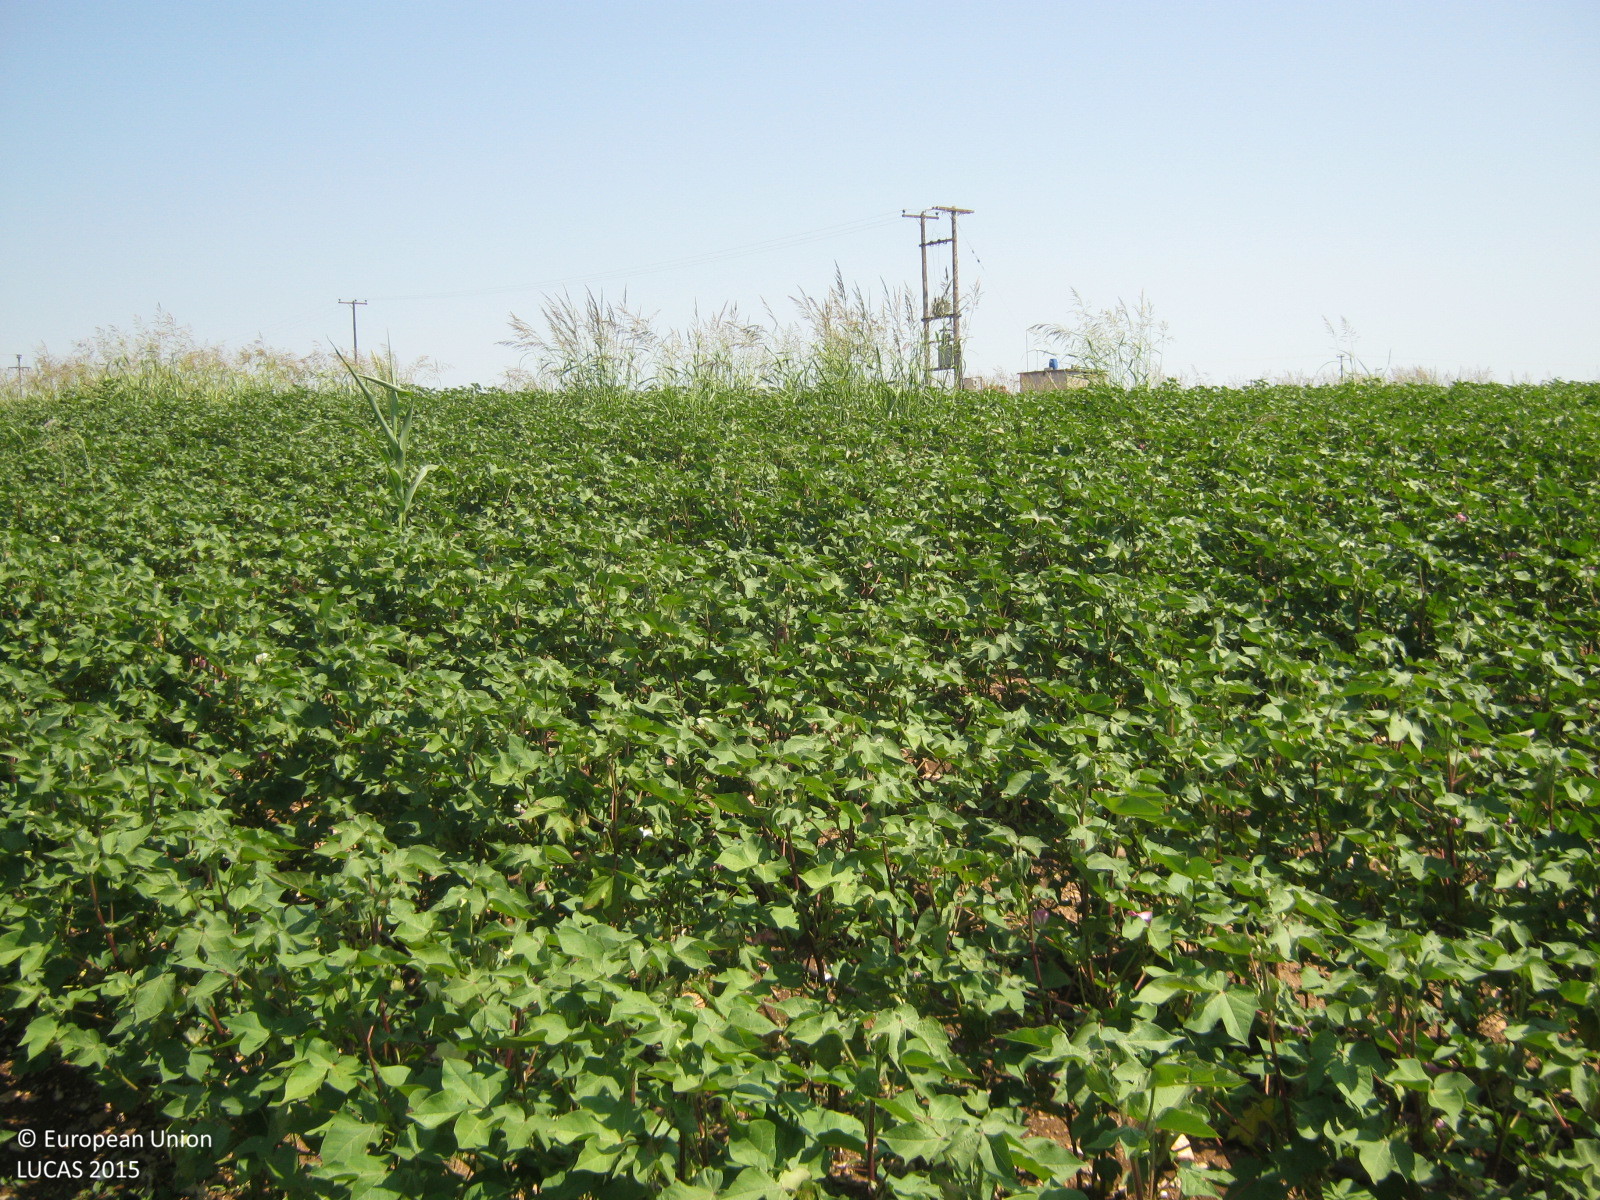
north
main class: Cropland
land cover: Cotton
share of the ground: > 75 %
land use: Agriculture (excluding fallow land and kitchen gardens)
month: July
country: GR
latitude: 39.3089
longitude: 22.7106
